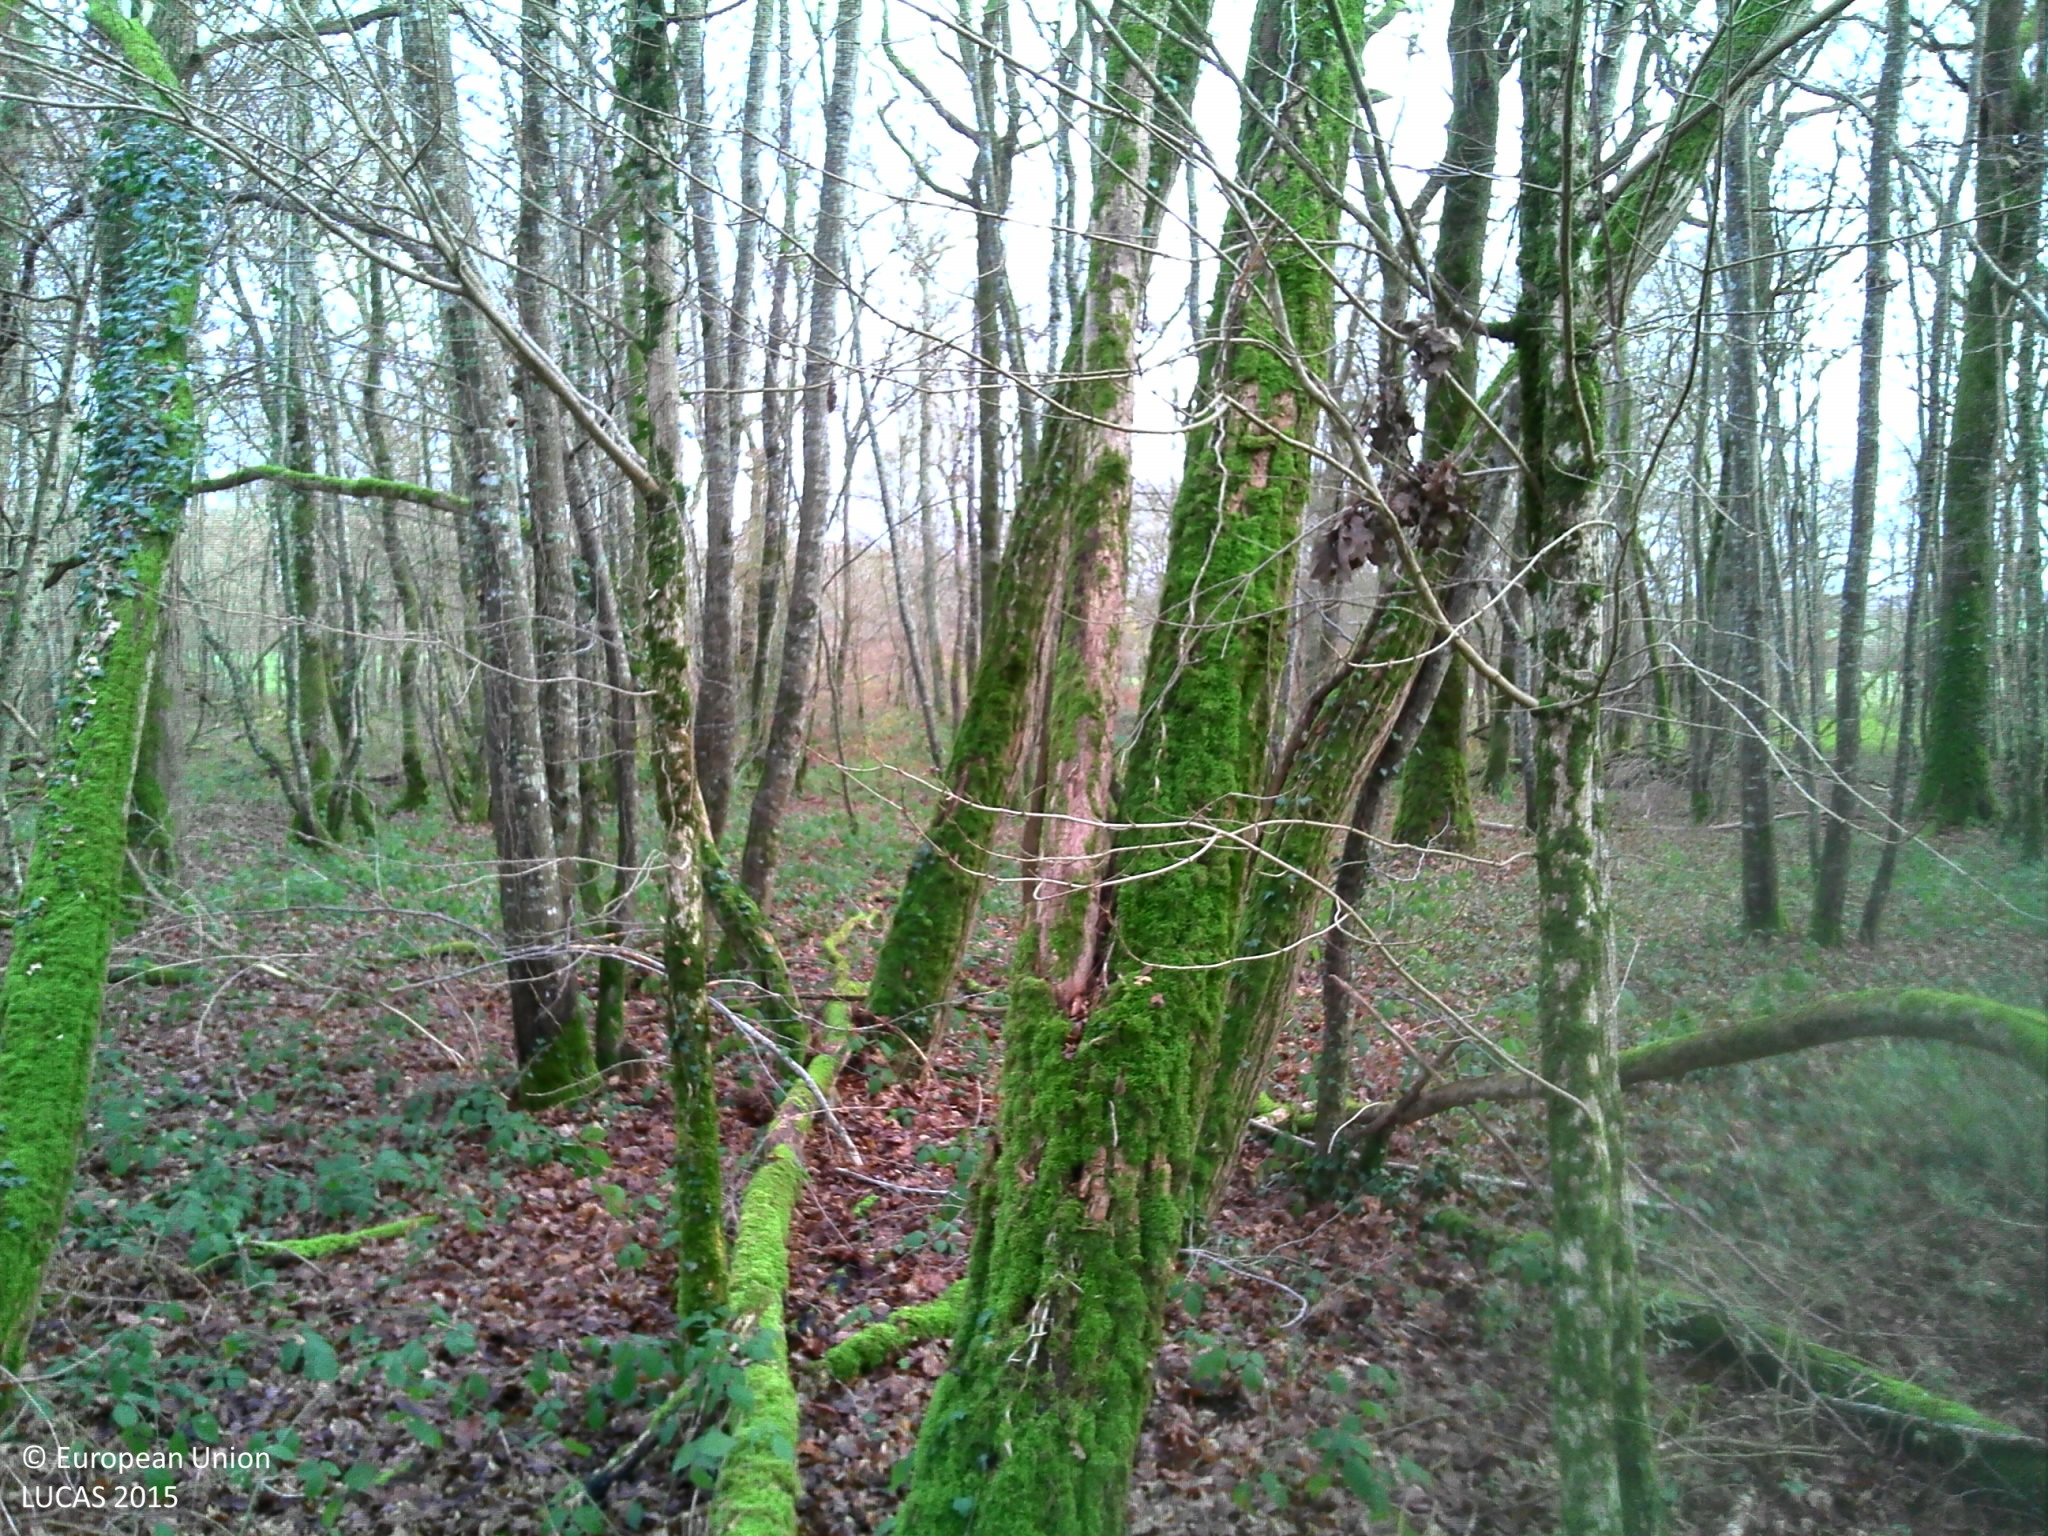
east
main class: Woodland
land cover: Broadleaved woodland
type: mesophytic deciduous forest
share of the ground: > 75 %
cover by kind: broadleaved forest trees 100 %
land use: Forestry
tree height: > 5 m
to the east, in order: Broadleaved woodland; Common wheat
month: December
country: FR
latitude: 47.2621
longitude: 3.6140
